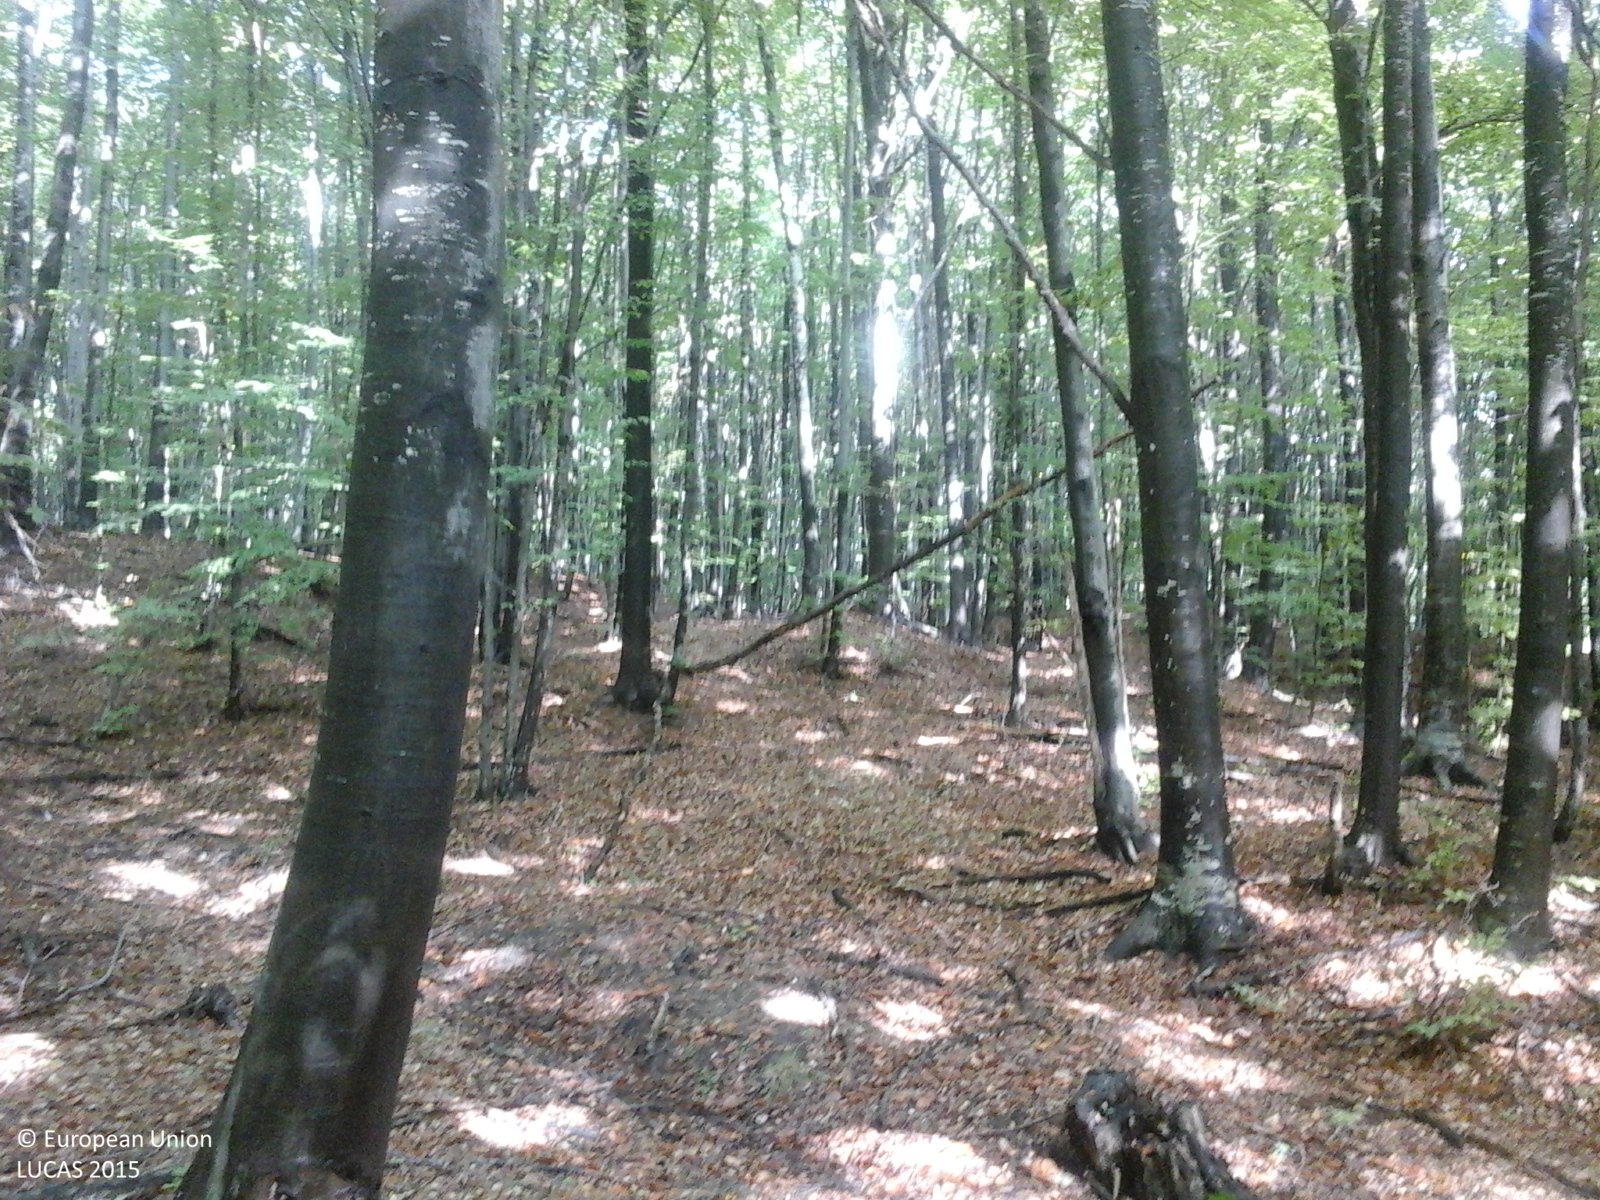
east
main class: Woodland
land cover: Broadleaved woodland
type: beech forest
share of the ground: > 75 %
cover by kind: broadleaved forest trees 100 %
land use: Forestry
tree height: > 5 m
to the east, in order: Broadleaved woodland; Grassland without tree/shrub cover; Tracks; Grassland without tree/shrub cover
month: September
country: RO
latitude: 45.3121
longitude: 24.4262
